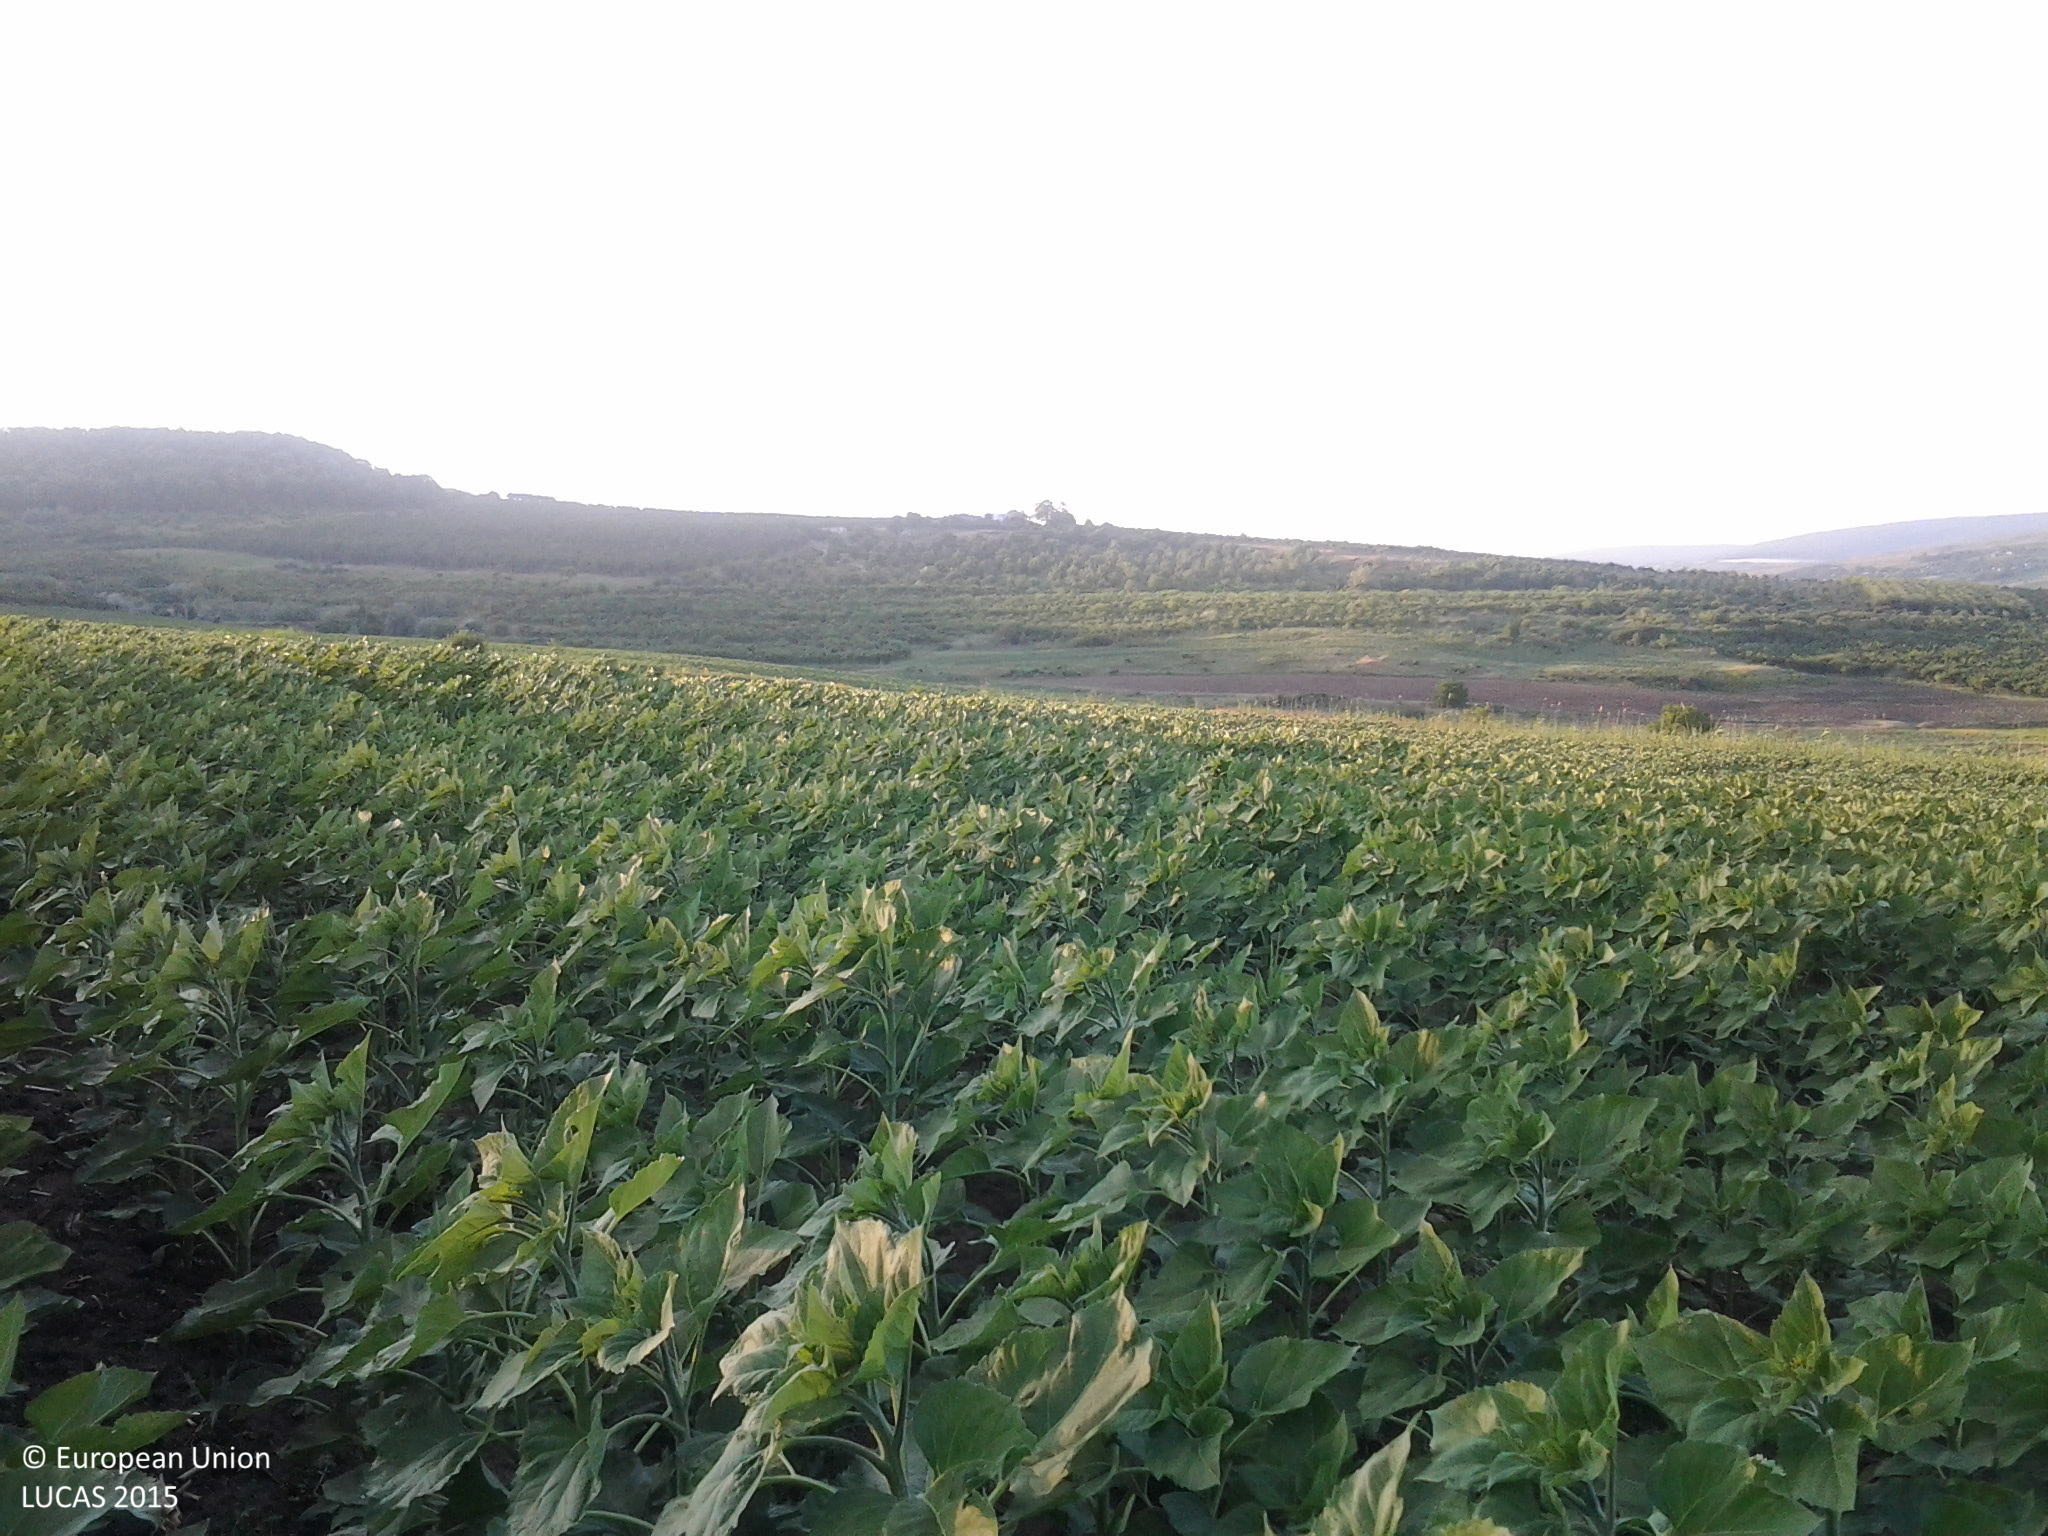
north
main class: Cropland
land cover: Sunflower
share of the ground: > 75 %
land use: Agriculture (excluding fallow land and kitchen gardens)
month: June
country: RO
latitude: 46.9083
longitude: 27.4556
